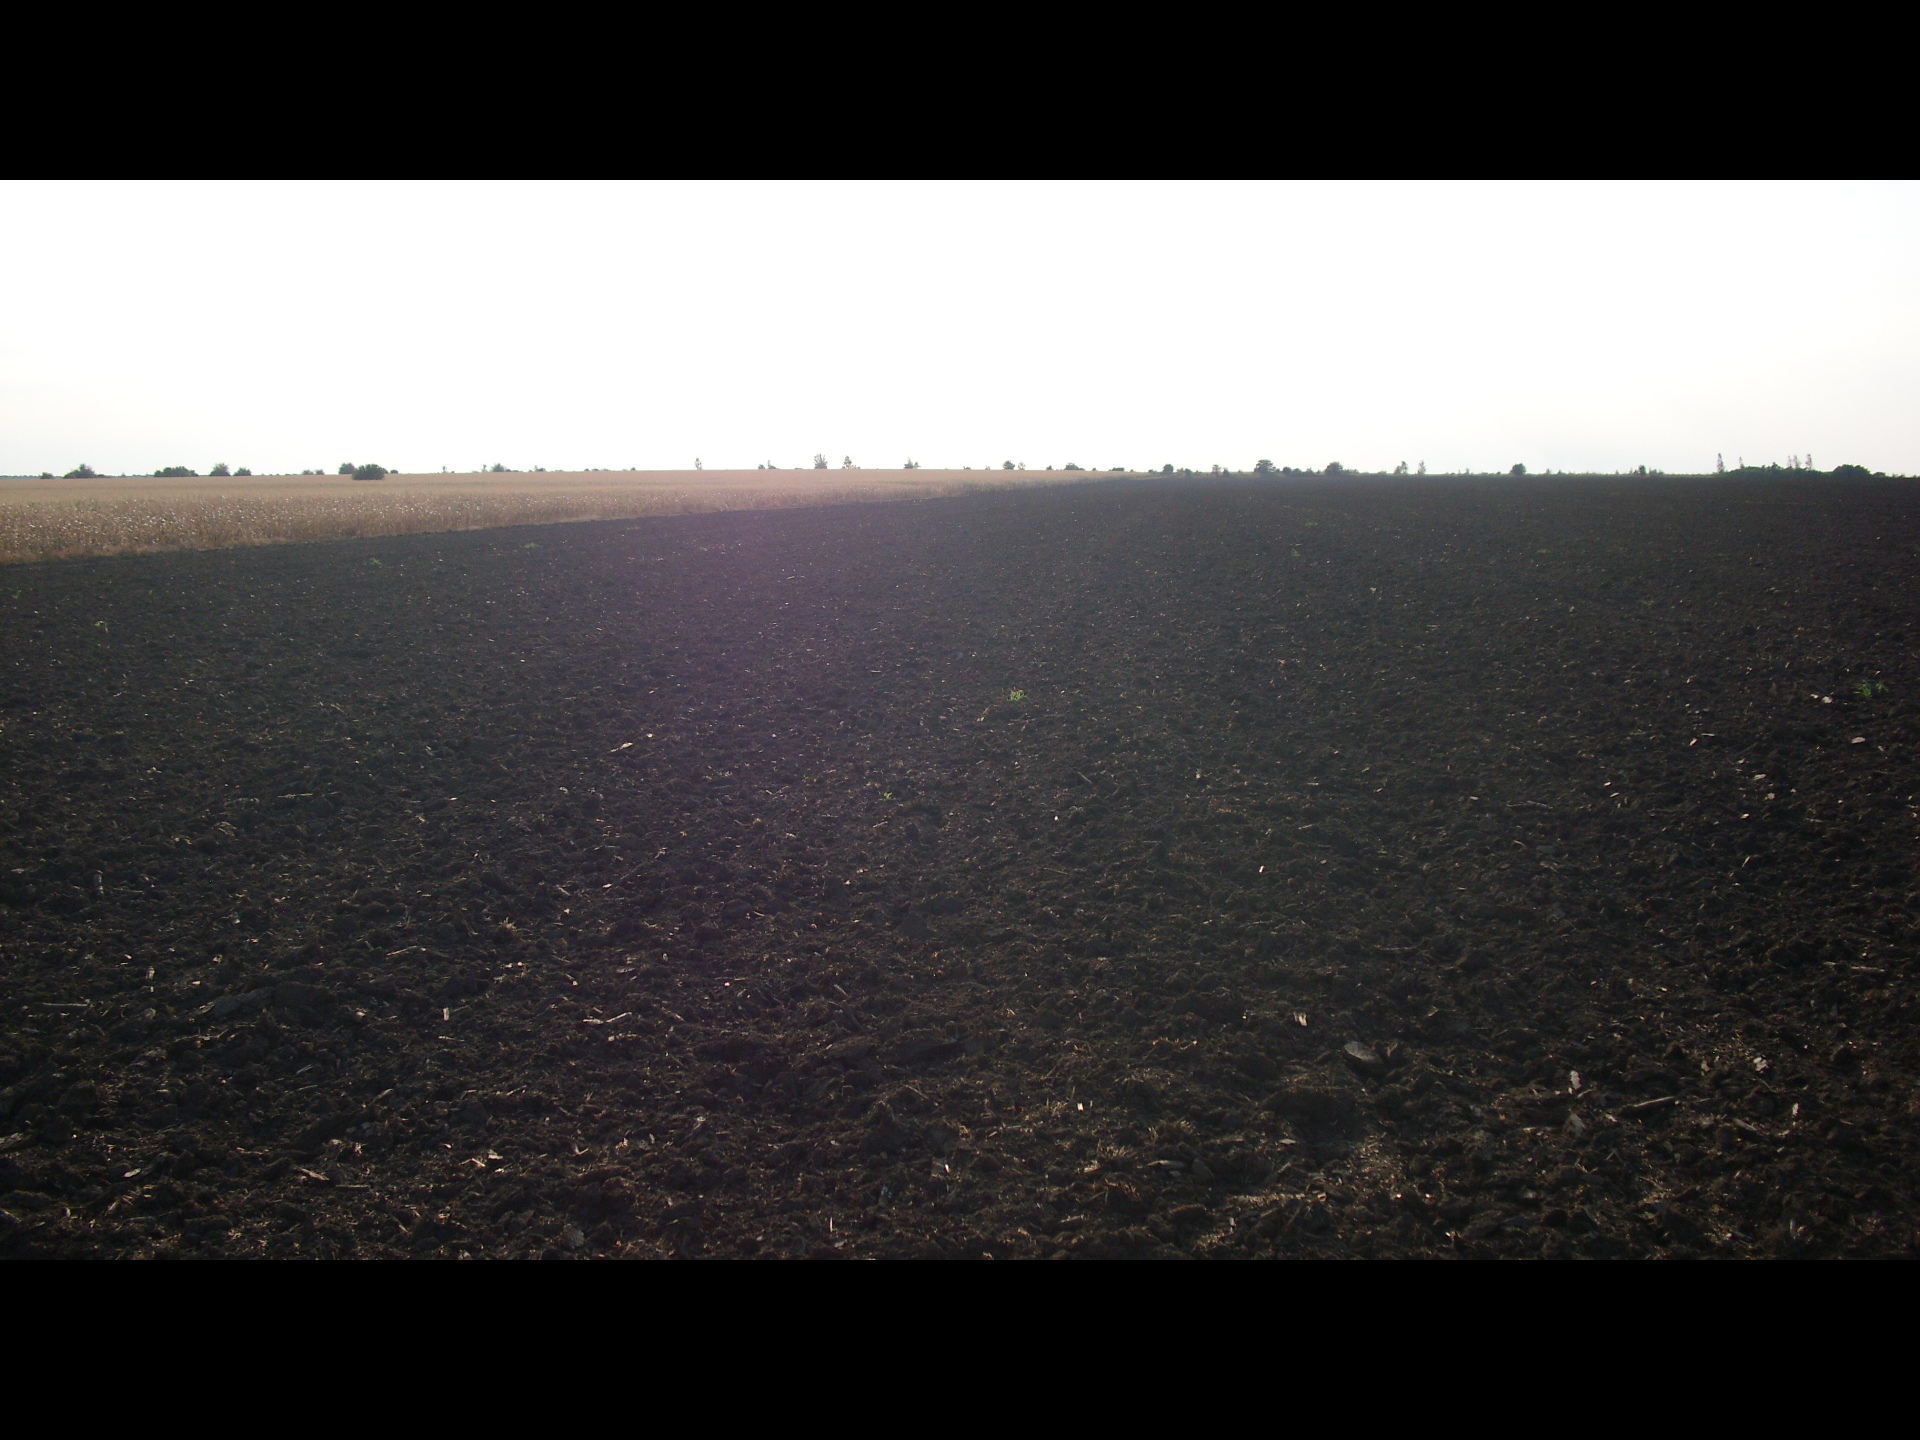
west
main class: Cropland
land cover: Common wheat
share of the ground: < 10 %
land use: Agriculture (excluding fallow land and kitchen gardens)
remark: Harvested field
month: August
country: BG
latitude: 43.6594
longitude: 23.6767
